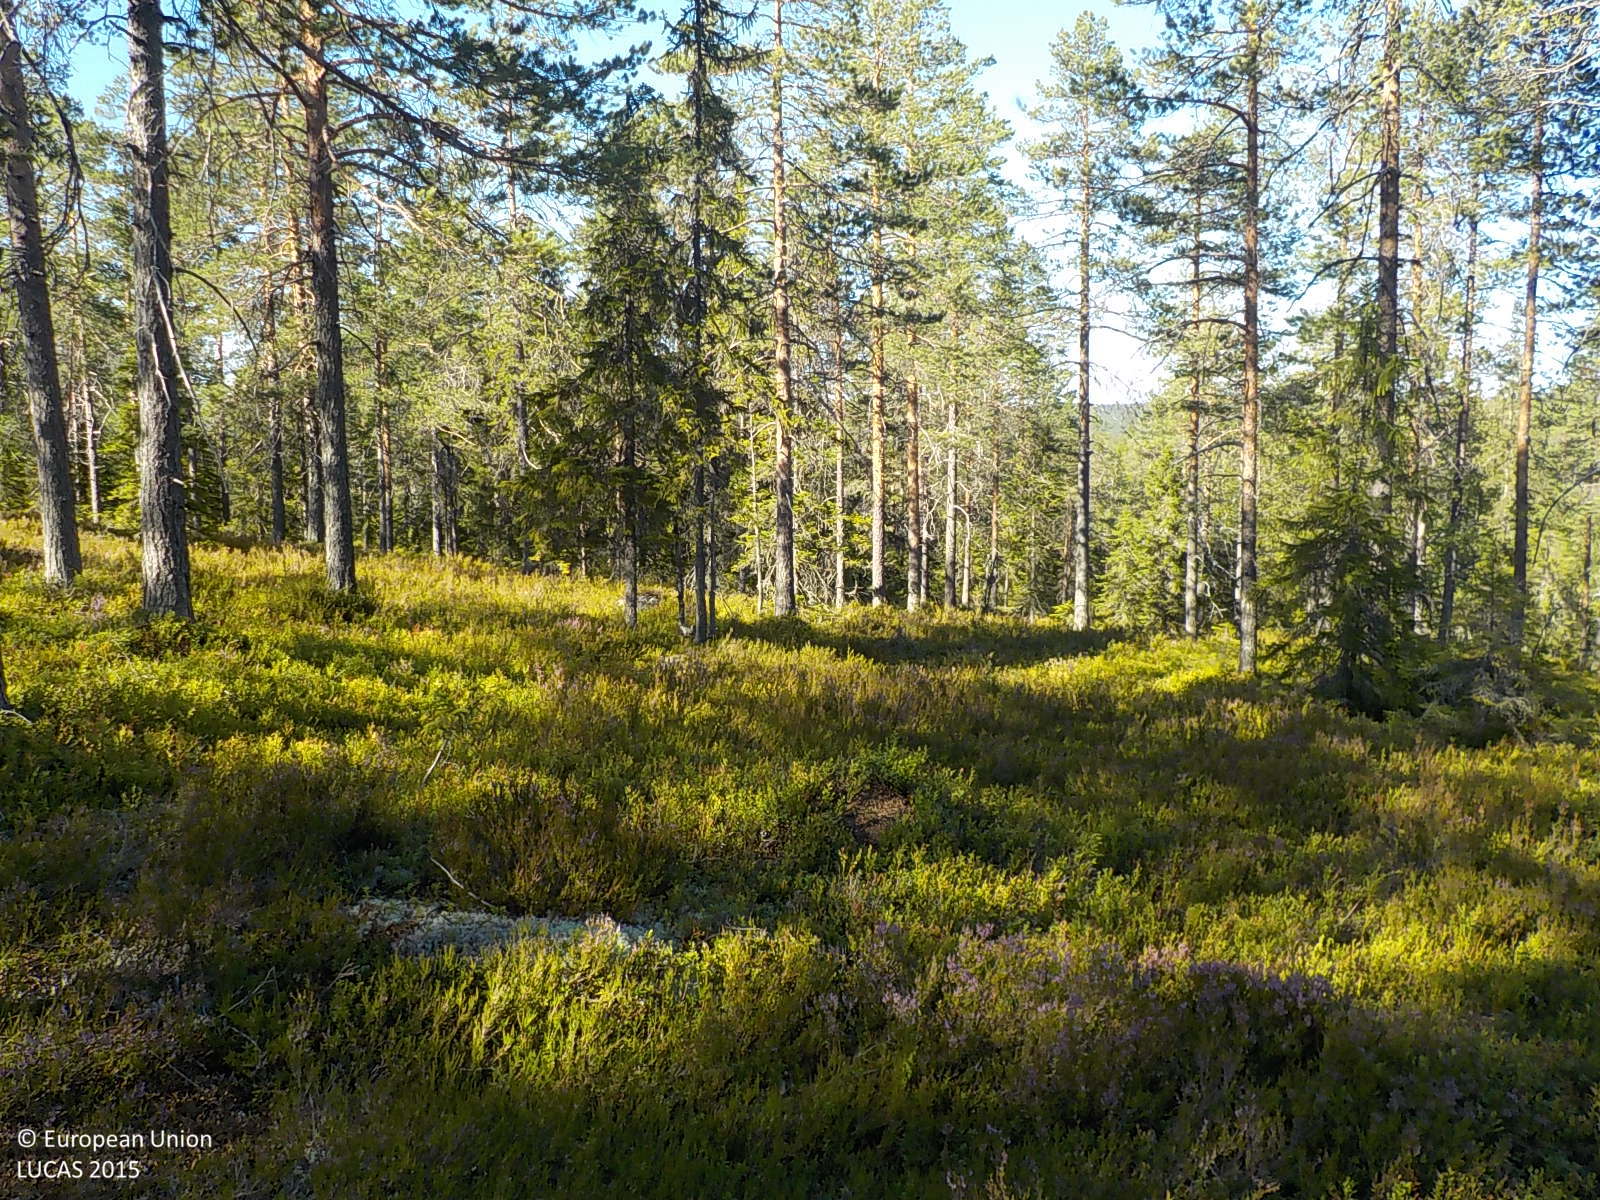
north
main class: Woodland
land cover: Pine dominated coniferous woodland
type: boreal forest
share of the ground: 25 - 50 %
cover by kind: shrubs 55 %, coniferous forest trees 40 %, broadleaved forest trees 5 %
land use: Forestry
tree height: > 5 m
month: August
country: SE
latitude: 63.4011
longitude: 18.6051
